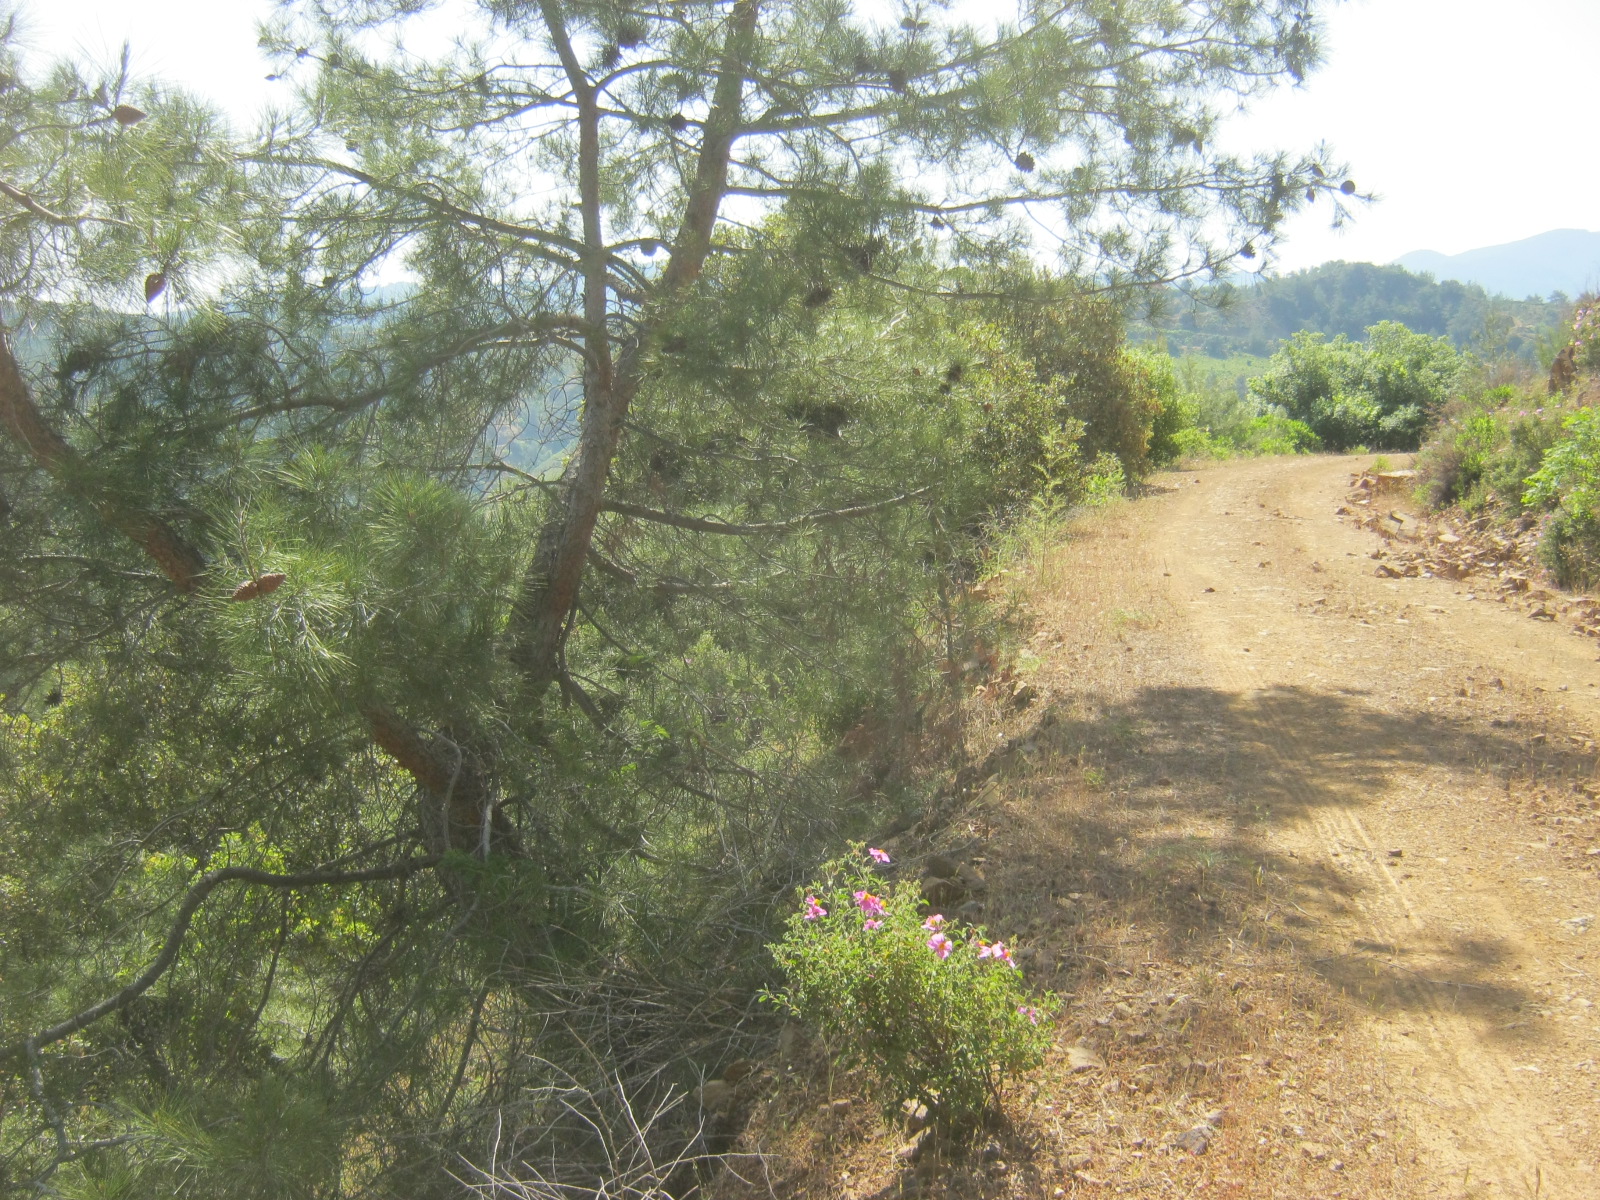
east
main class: Woodland
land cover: Pine dominated coniferous woodland
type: coniferous forest of the mediterranean region
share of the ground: 50 - 75 %
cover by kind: coniferous forest trees 60 %, shrubs 20 %, unconsolidated bare surface 20 %
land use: Forestry
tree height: > 5 m
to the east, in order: Pine dominated coniferous woodland; Shrubland with sparse tree cover; Pine dominated coniferous woodland; Vineyards; Rivers and streams; Pine dominated coniferous woodland
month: May
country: CY
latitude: 35.0145
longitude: 32.7962
